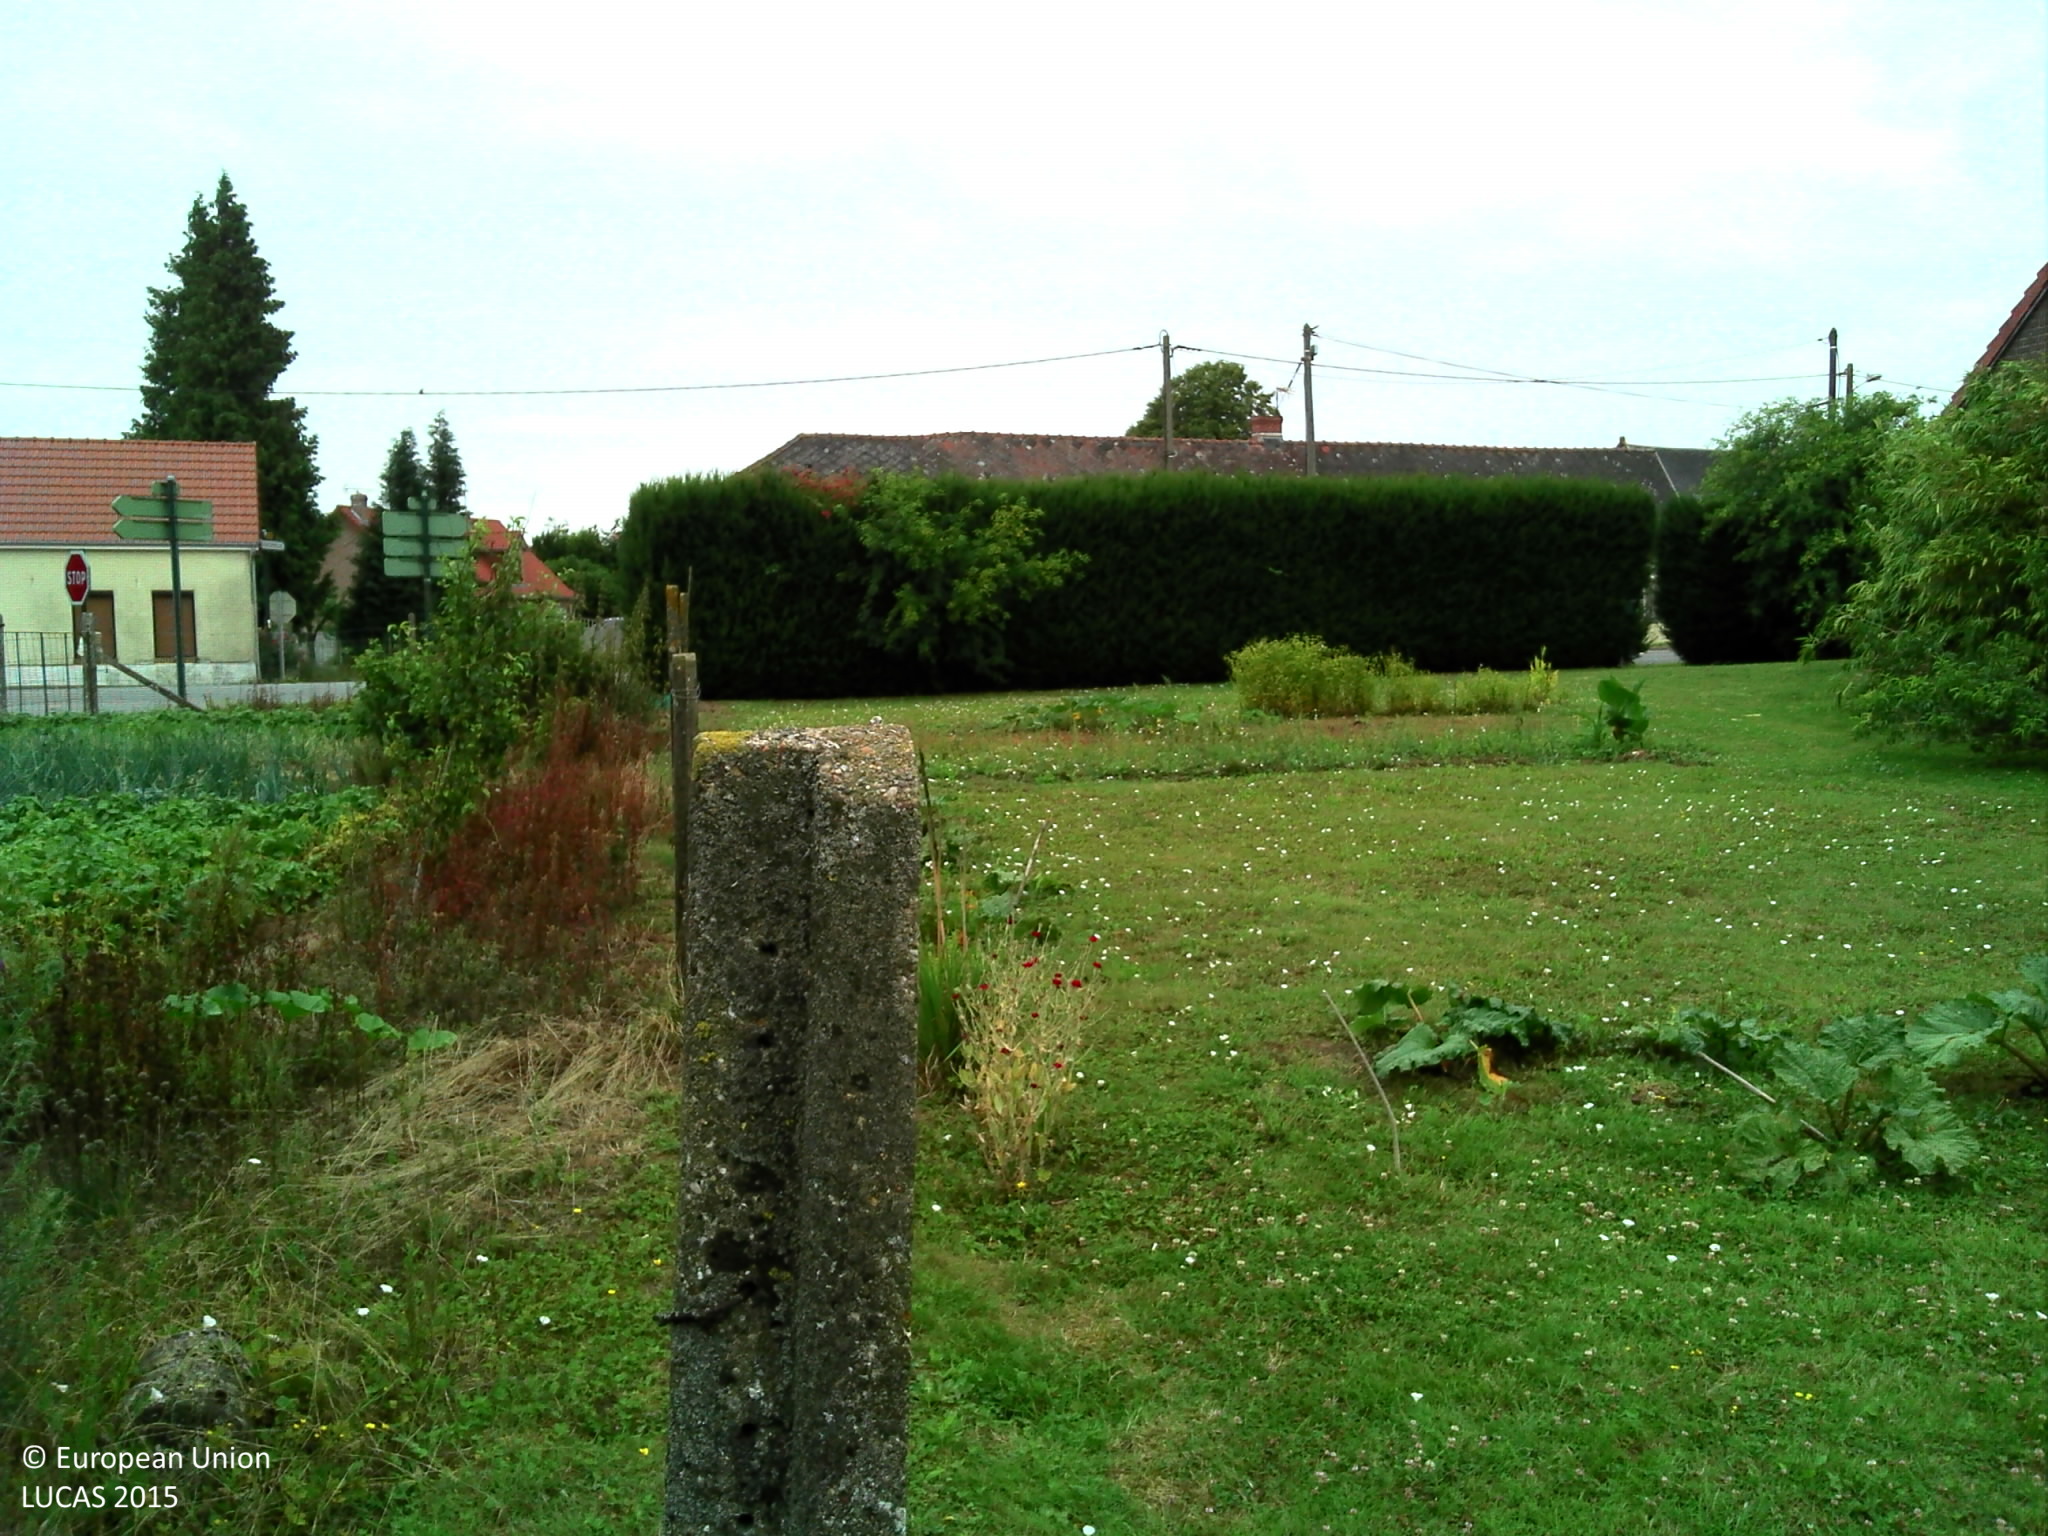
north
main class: Grassland
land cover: Grassland without tree/shrub cover
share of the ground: > 75 %
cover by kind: herbaceous plants 95 %
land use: Residential
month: July
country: FR
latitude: 50.1895
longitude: 2.4940
